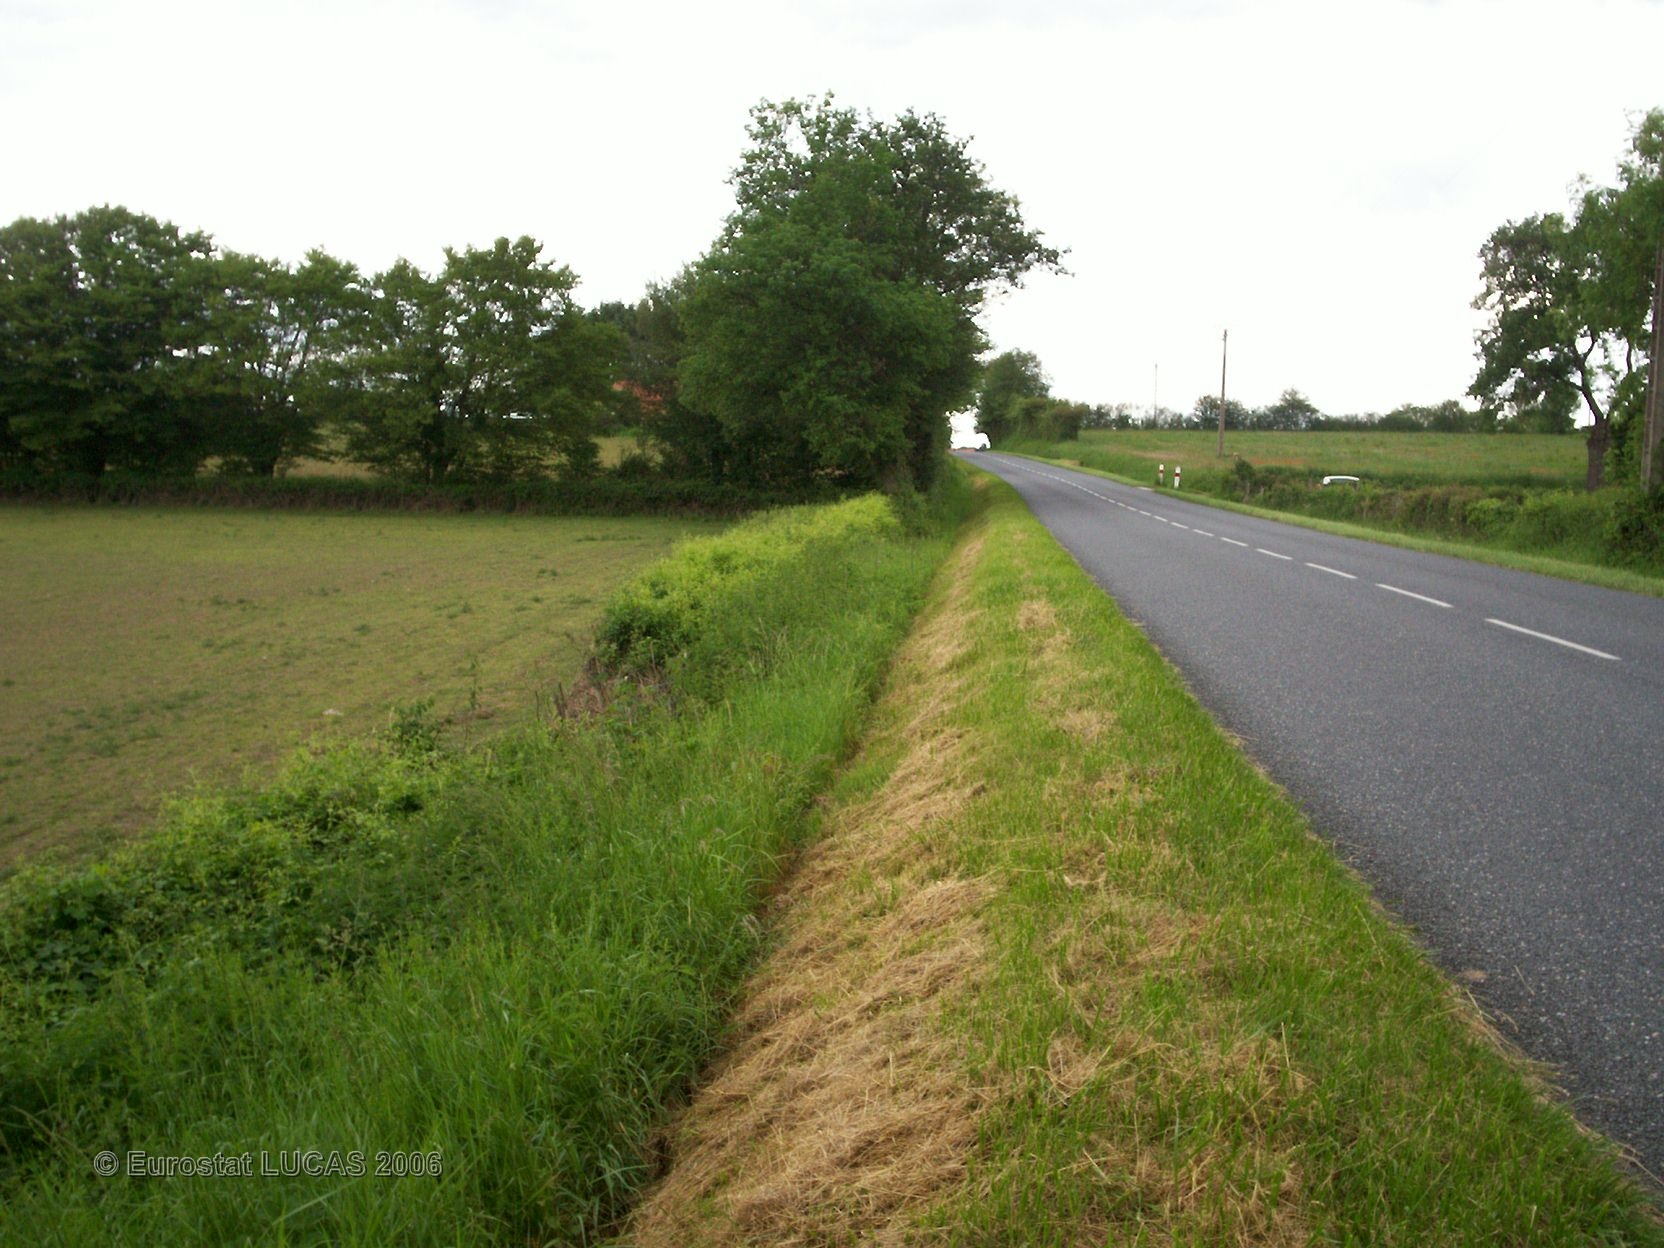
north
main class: Grassland
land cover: Grassland with sparse tree/shrub cover
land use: Agriculture (excluding fallow land and kitchen gardens)
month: May
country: FR
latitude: 46.8955
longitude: 2.9473
